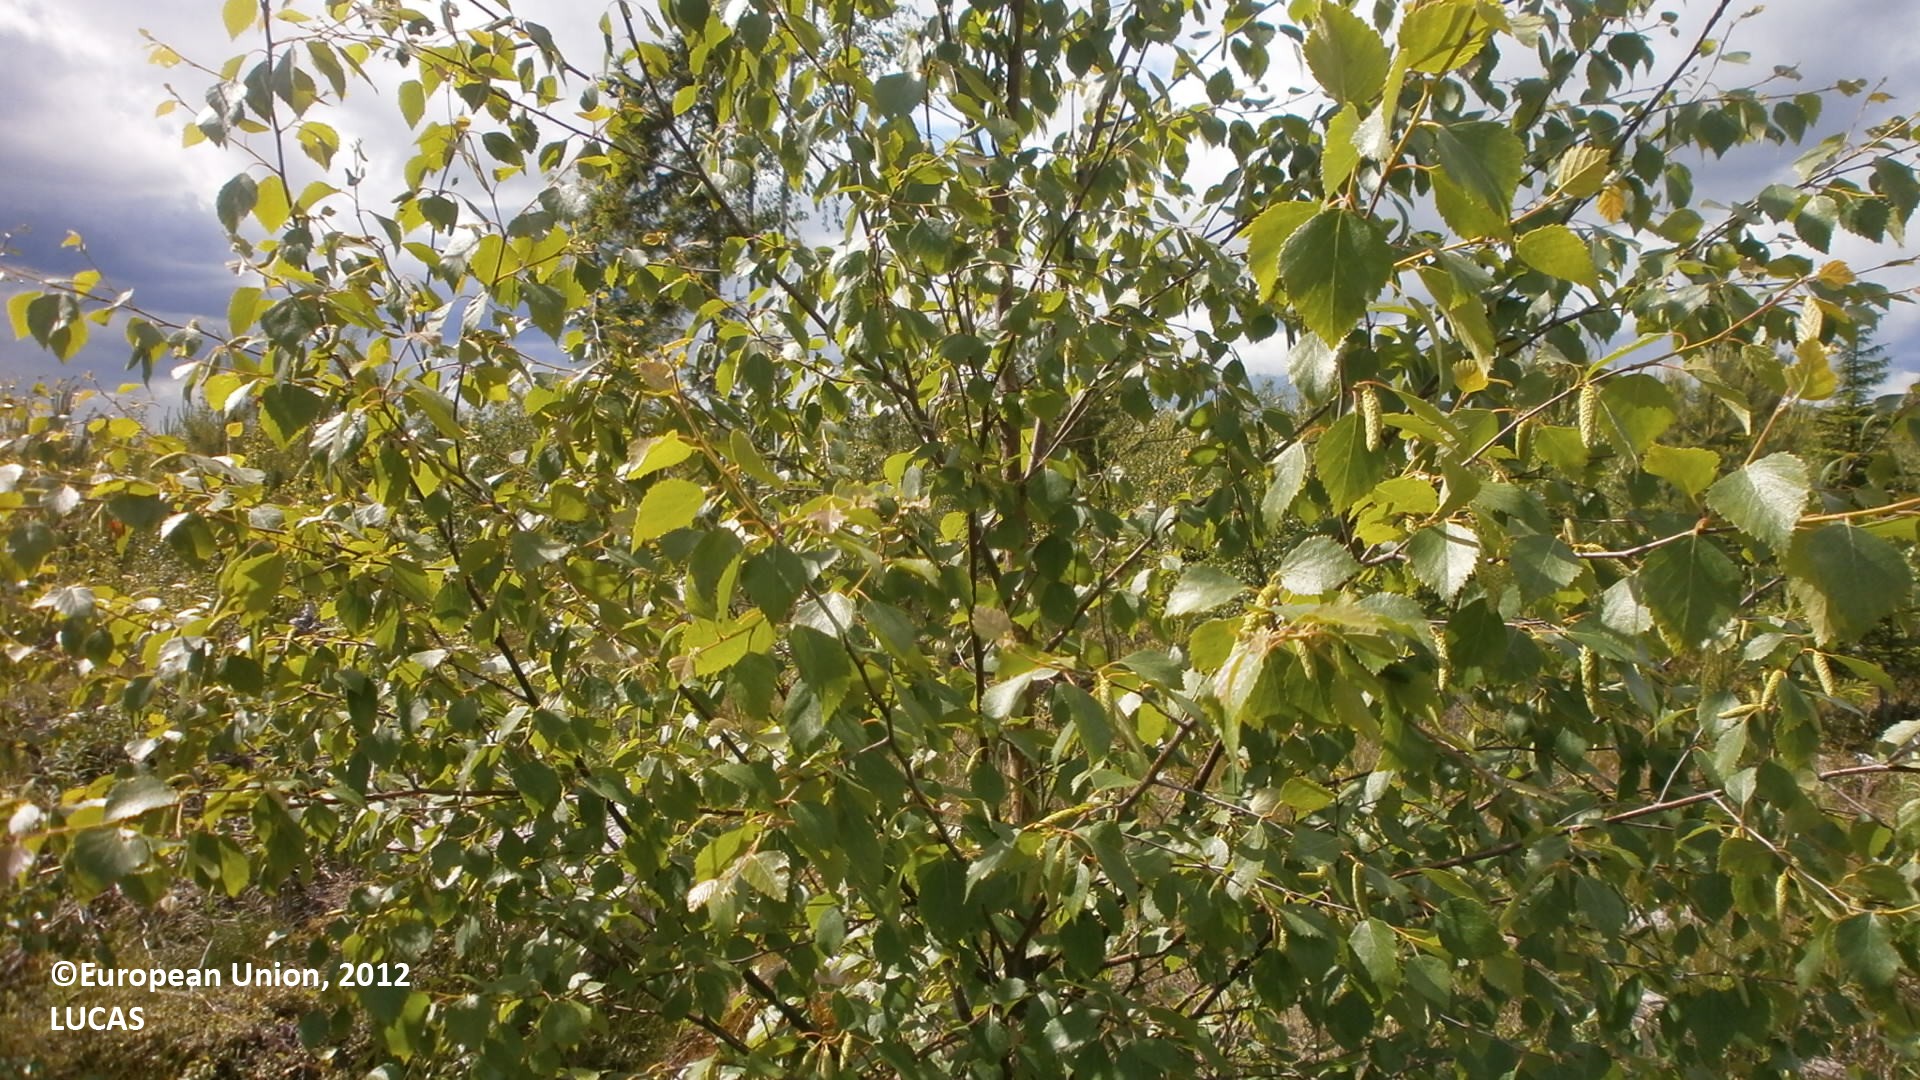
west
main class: Woodland
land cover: Broadleaved woodland
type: boreal forest
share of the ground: 10 - 25 %
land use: Forestry
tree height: < 5 m
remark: Clear cut
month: June
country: FI
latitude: 64.2907
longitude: 24.9774
